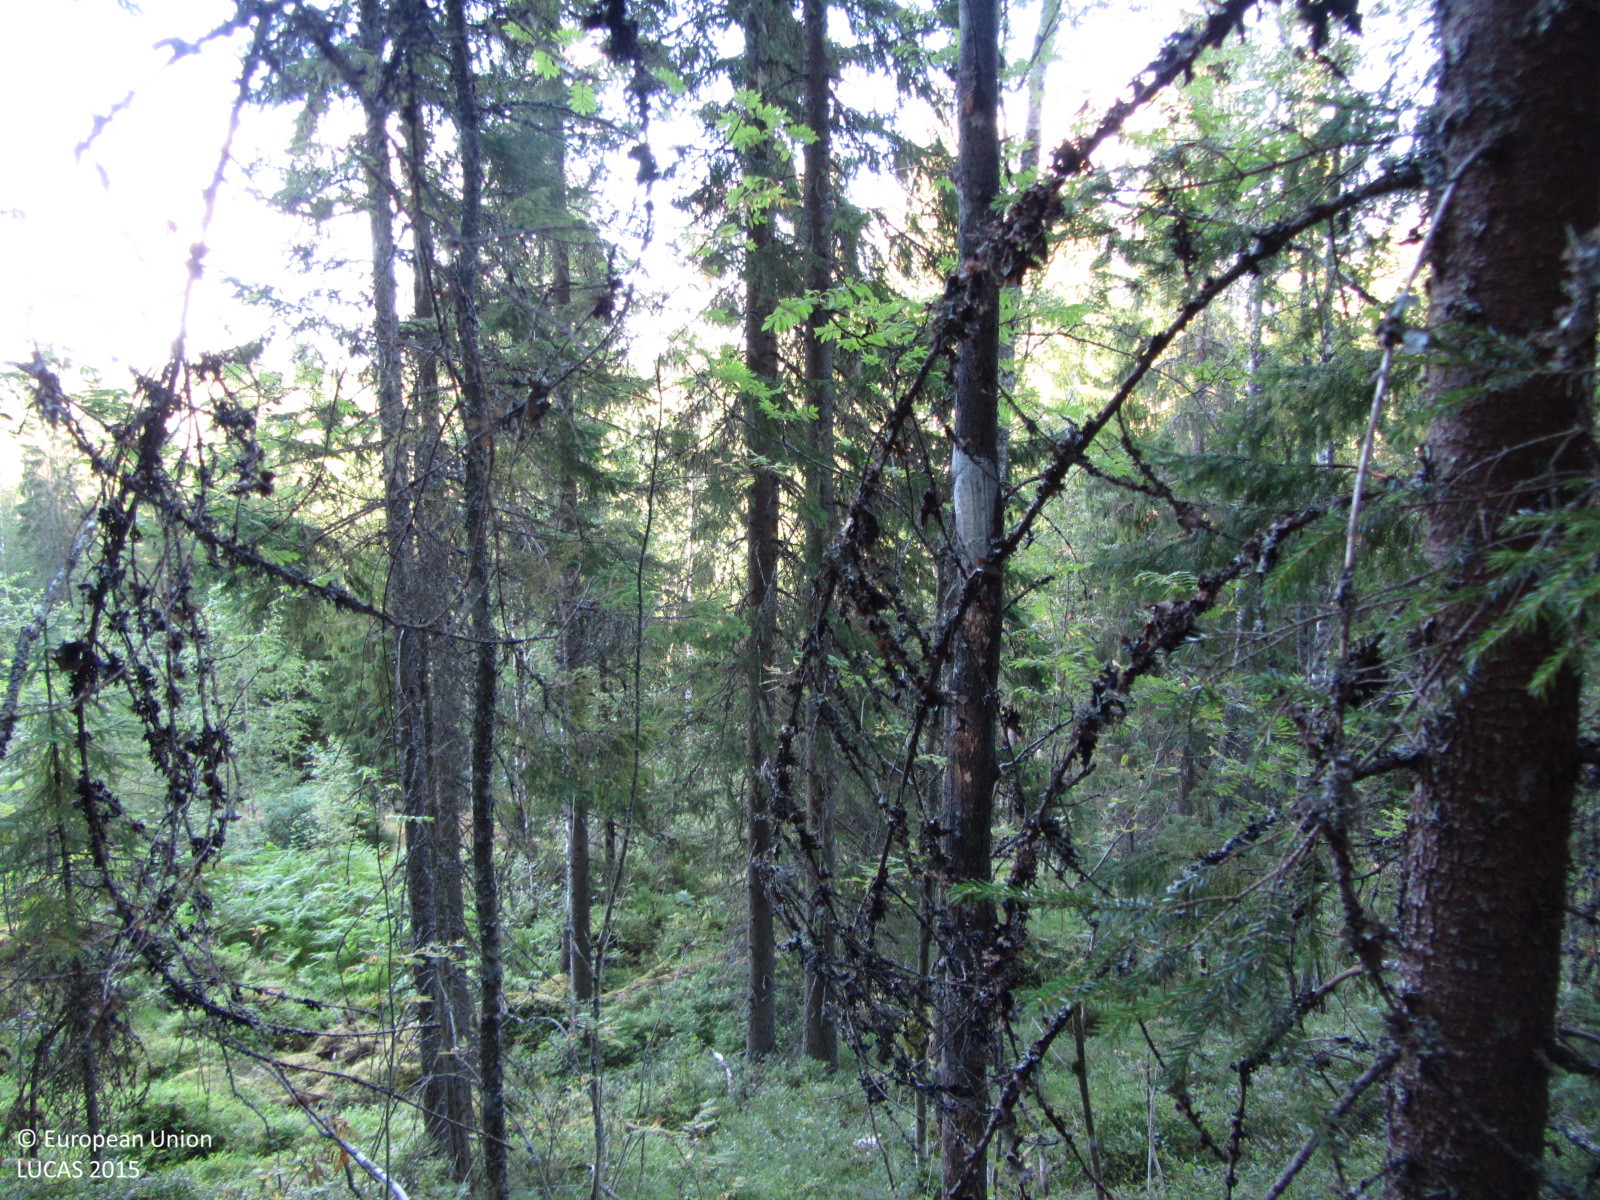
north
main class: Woodland
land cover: Spruce dominated mixed woodland
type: boreal forest
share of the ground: > 75 %
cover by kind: coniferous forest trees 50 %, broadleaved forest trees 30 %, shrubs 15 %, lichens and mosses 5 %
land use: Forestry
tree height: > 5 m
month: August
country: FI
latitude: 60.4419
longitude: 23.8876
